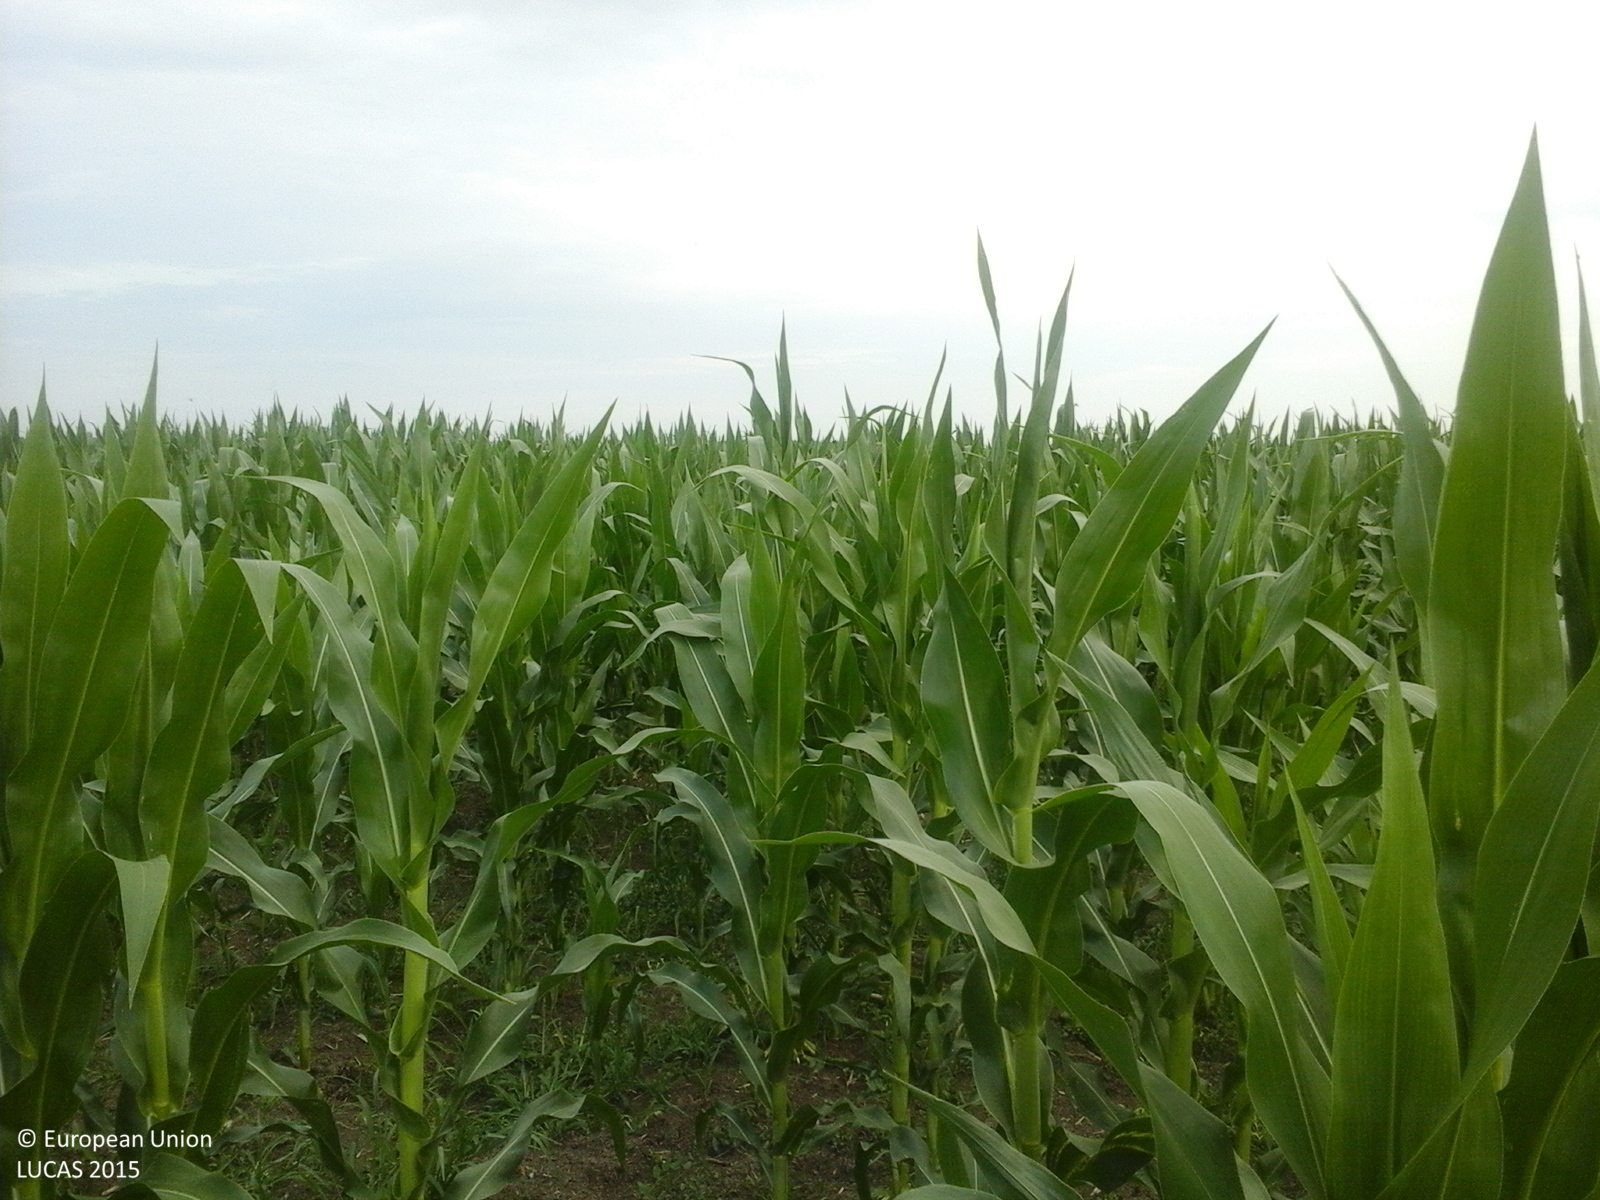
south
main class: Cropland
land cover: Maize
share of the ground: > 75 %
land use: Agriculture (excluding fallow land and kitchen gardens)
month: June
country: RO
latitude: 44.0211
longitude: 26.2090
